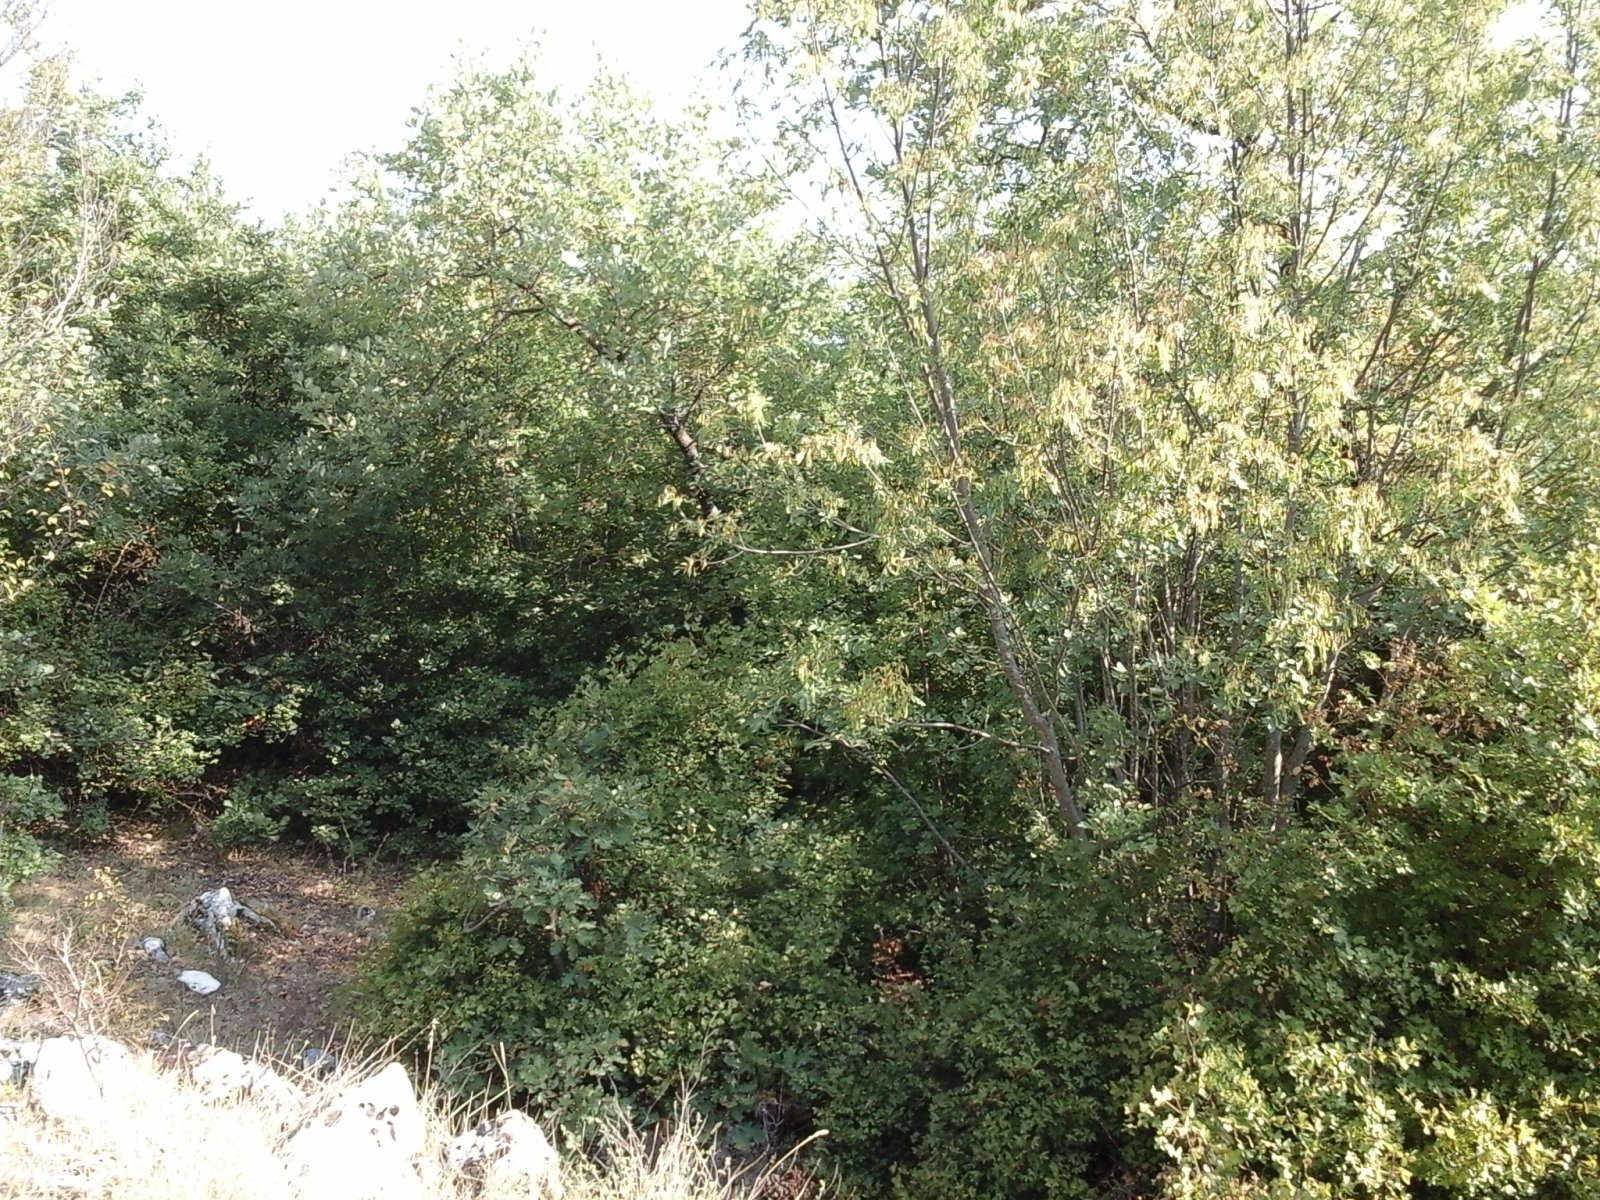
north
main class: Woodland
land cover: Broadleaved woodland
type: thermophilous deciduous forest
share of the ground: > 75 %
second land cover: Grassland without tree/shrub cover
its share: > 75 %
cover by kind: broadleaved forest trees 90 %, shrubs 5 %, herbaceous plants 5 %
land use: Forestry
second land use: Agriculture (excluding fallow land and kitchen gardens)
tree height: > 5 m
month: August
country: IT
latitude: 41.5511
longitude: 14.2646
